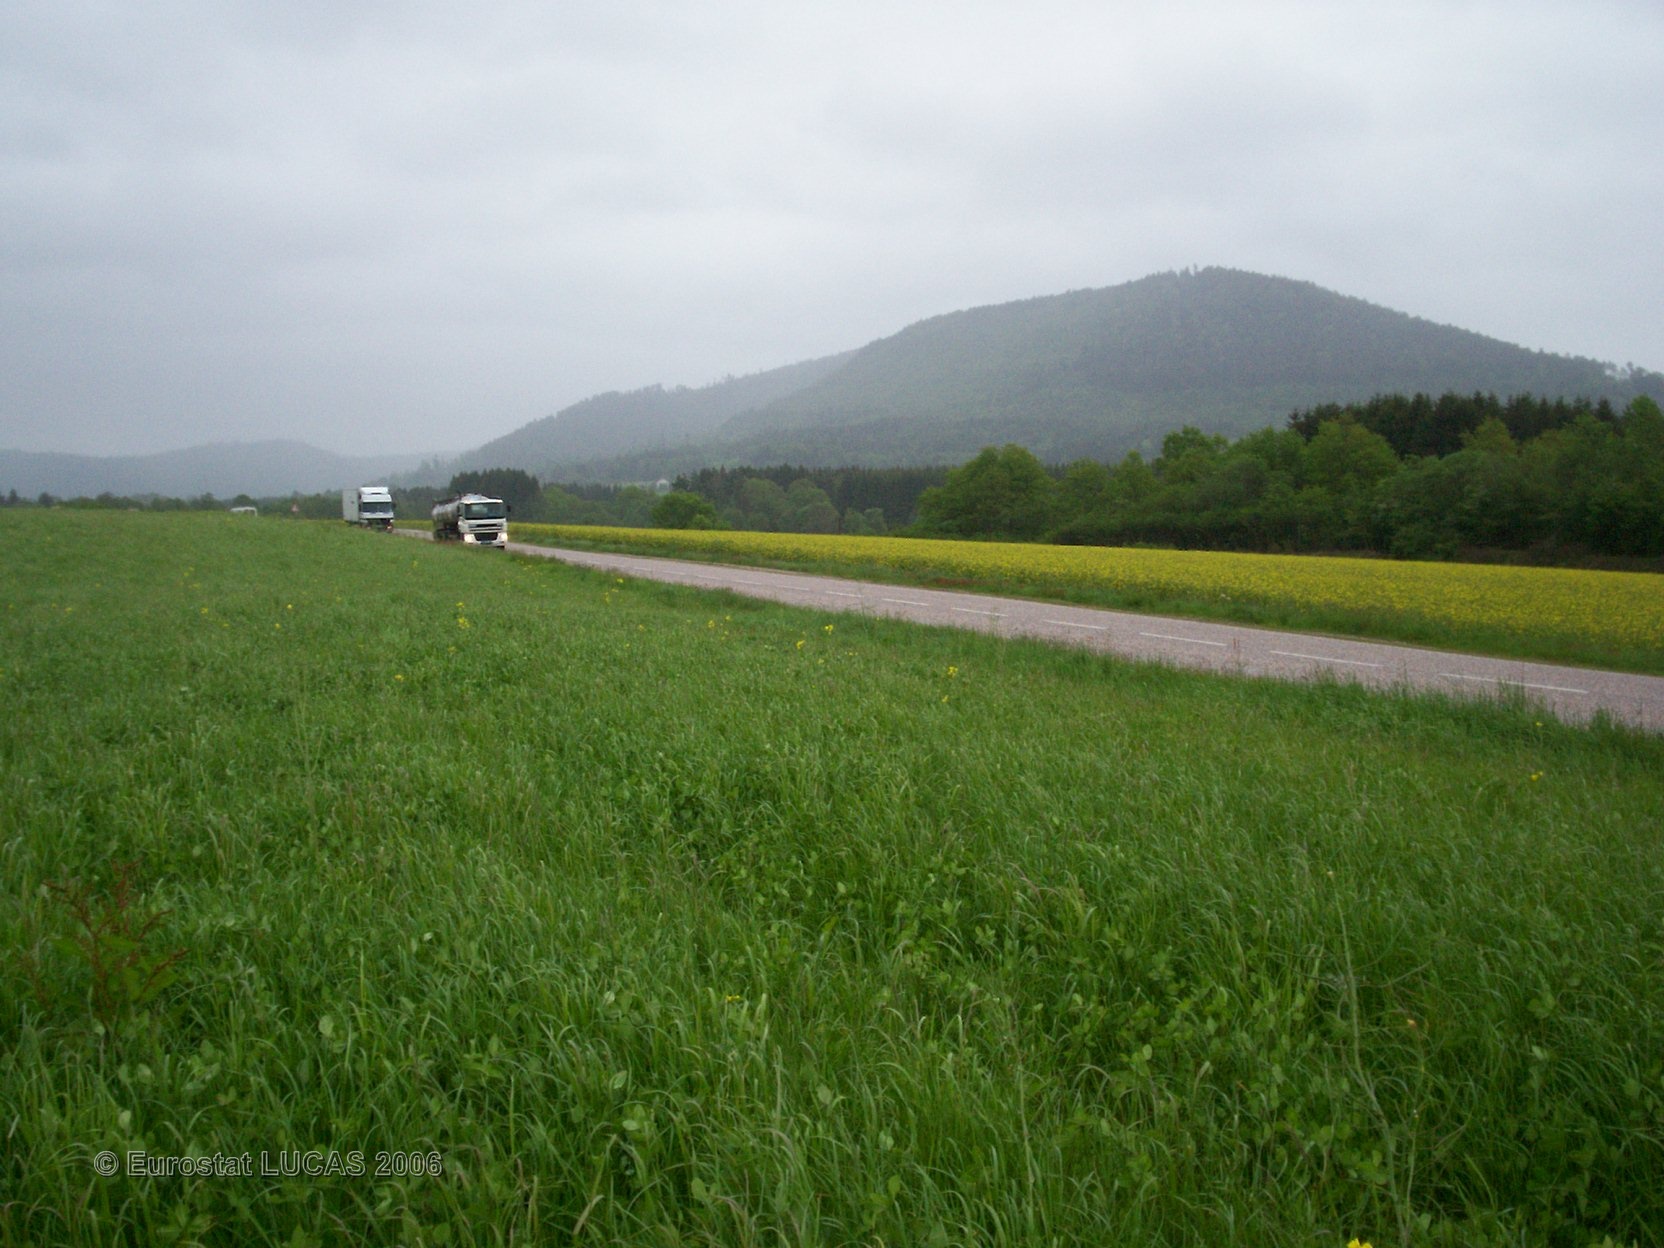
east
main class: Cropland
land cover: Other leguminous and mixtures for fodder
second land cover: Clovers
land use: Agriculture (excluding fallow land and kitchen gardens)
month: May
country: FR
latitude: 48.1947
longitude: 6.7856
